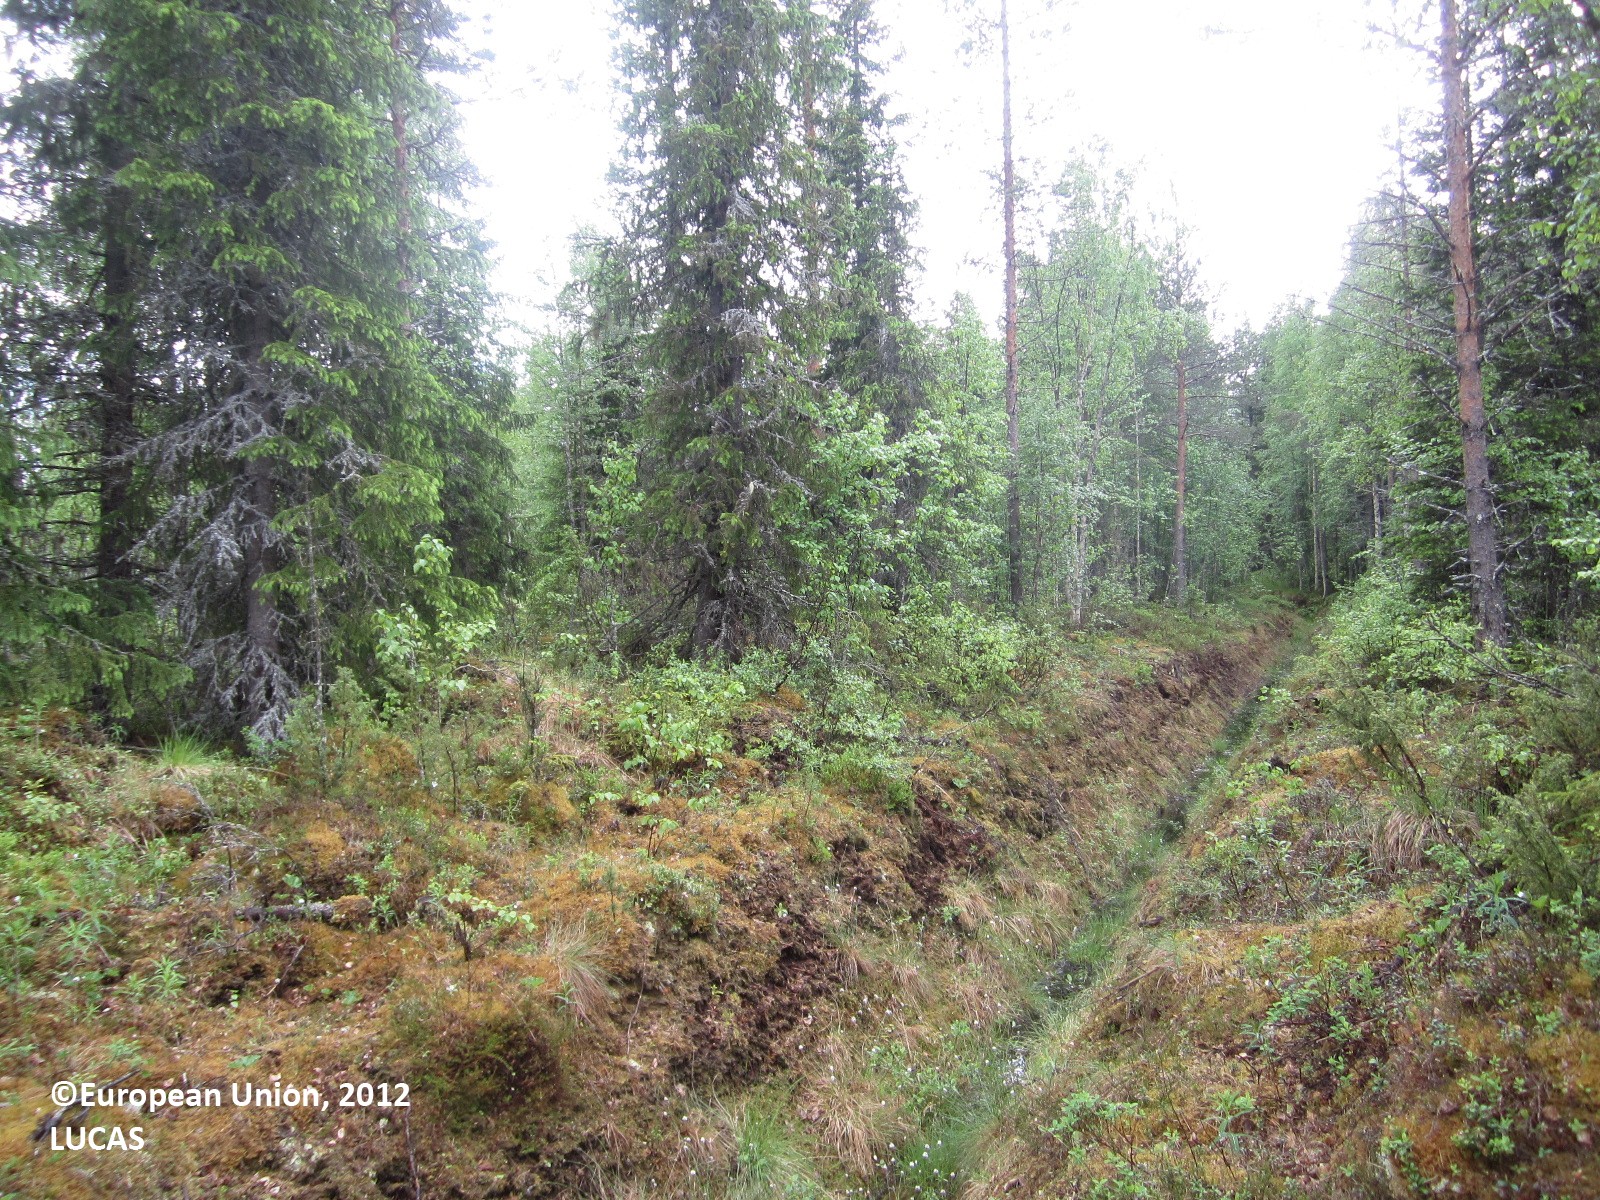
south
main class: Woodland
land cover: Other coniferous woodland
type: boreal forest
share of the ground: > 75 %
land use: Forestry
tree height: > 5 m
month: June
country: FI
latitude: 64.6667
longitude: 29.8080
